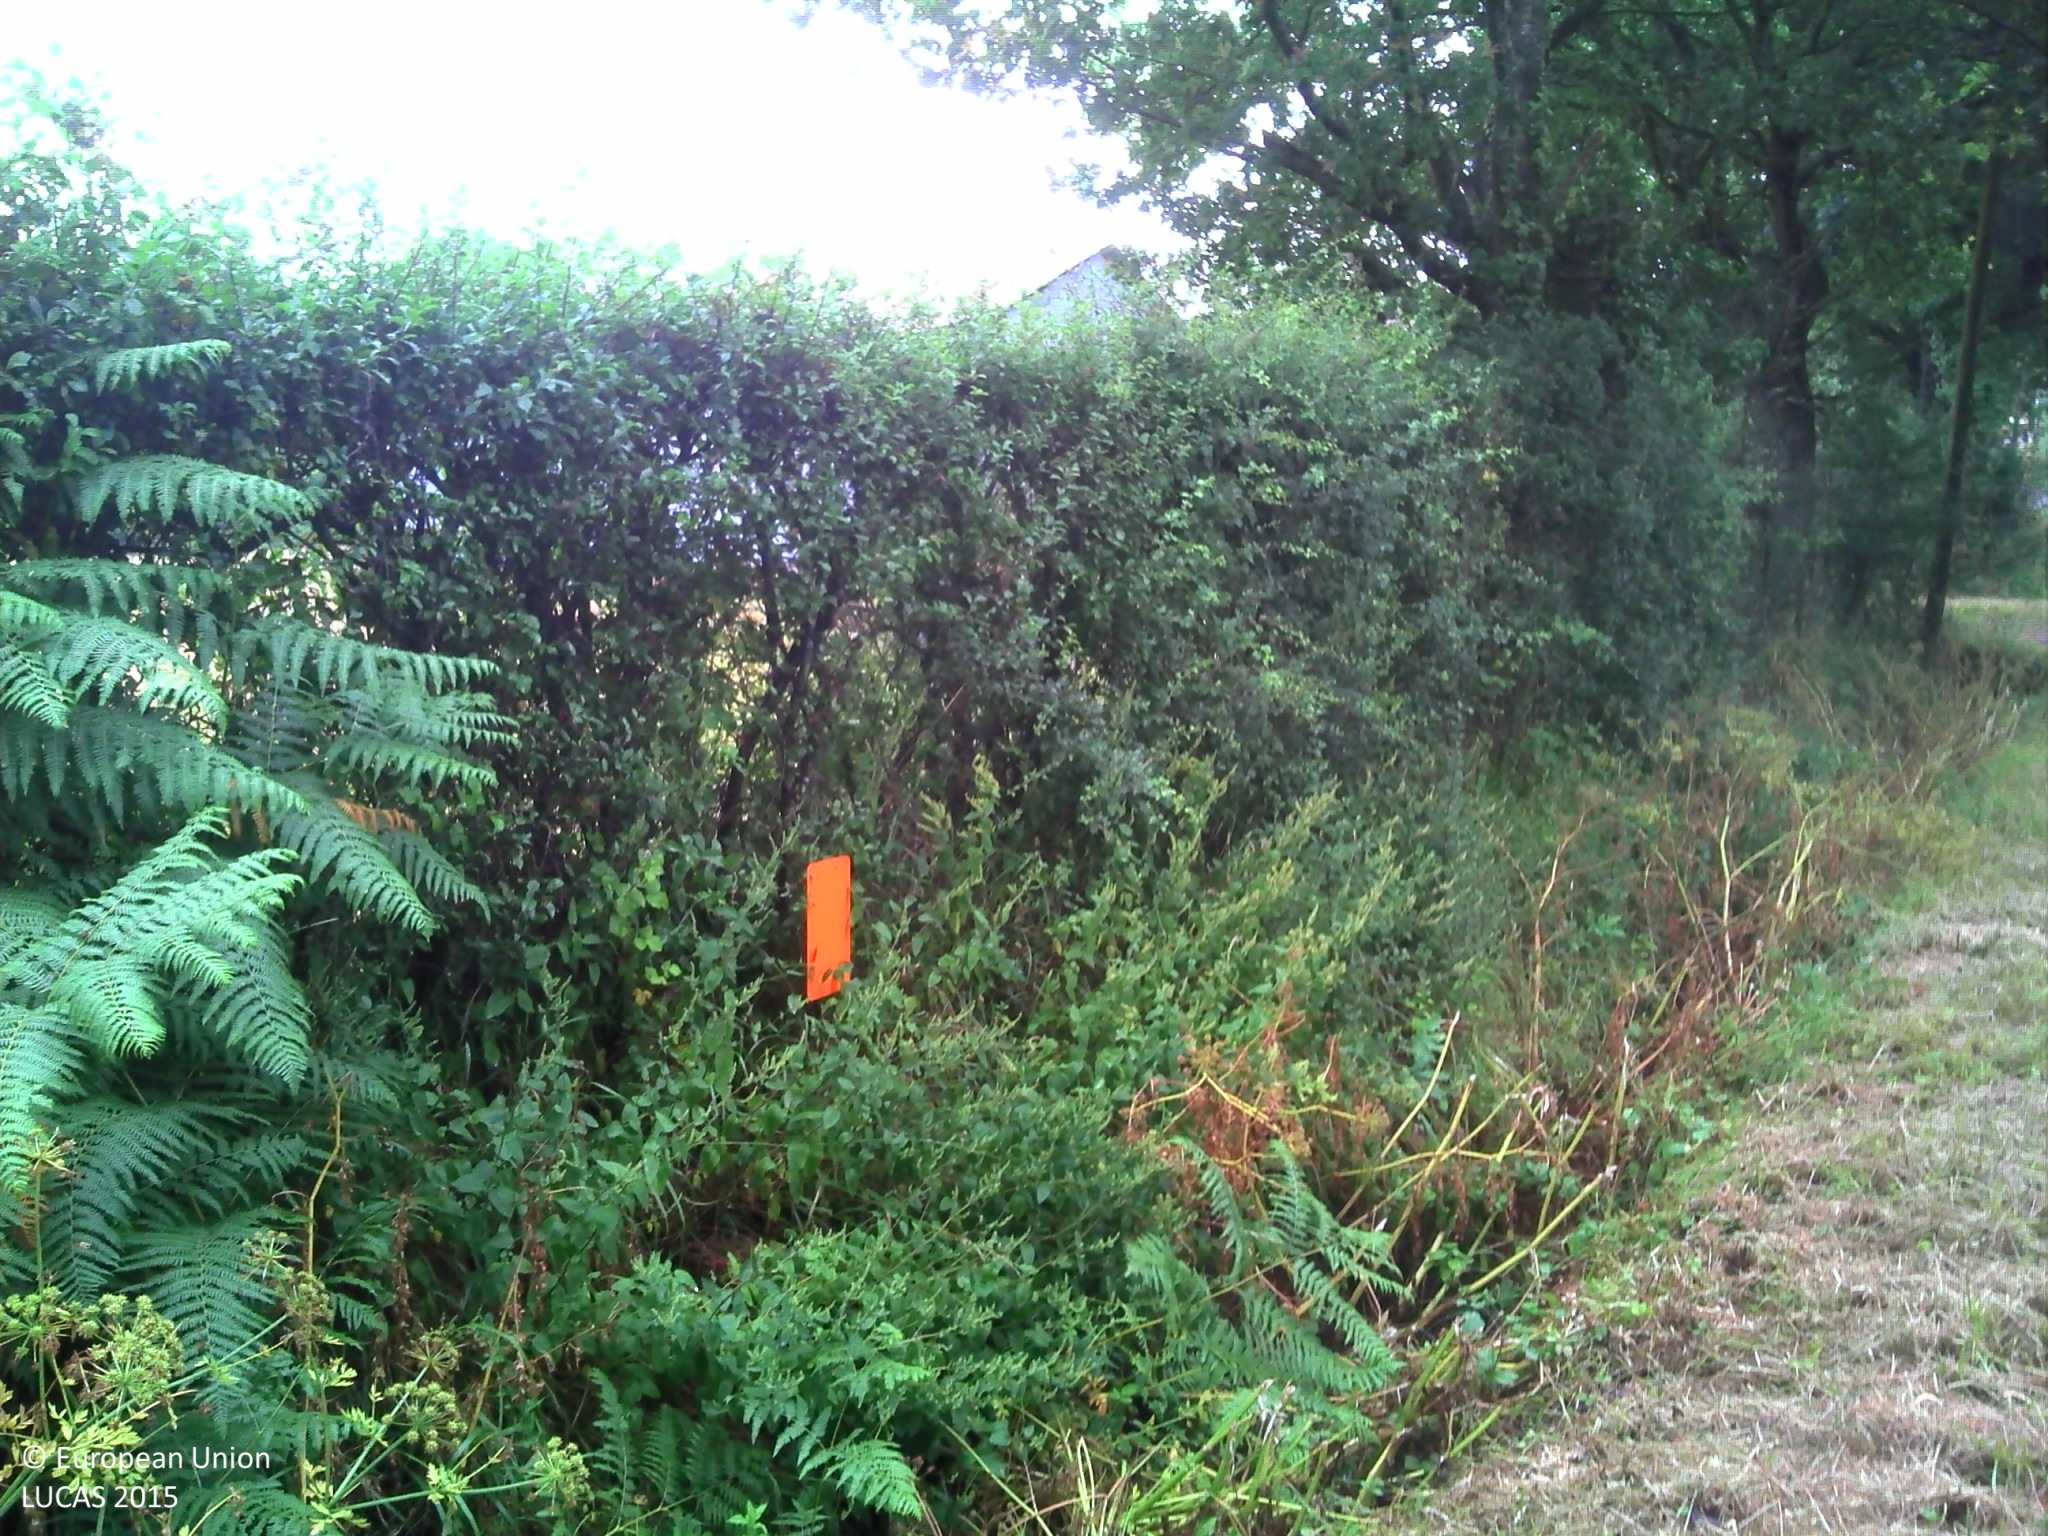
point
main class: Grassland
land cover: Grassland without tree/shrub cover
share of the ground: > 75 %
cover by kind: herbaceous plants 100 %
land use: Agriculture (excluding fallow land and kitchen gardens)
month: July
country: FR
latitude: 47.1896
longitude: -1.7778
